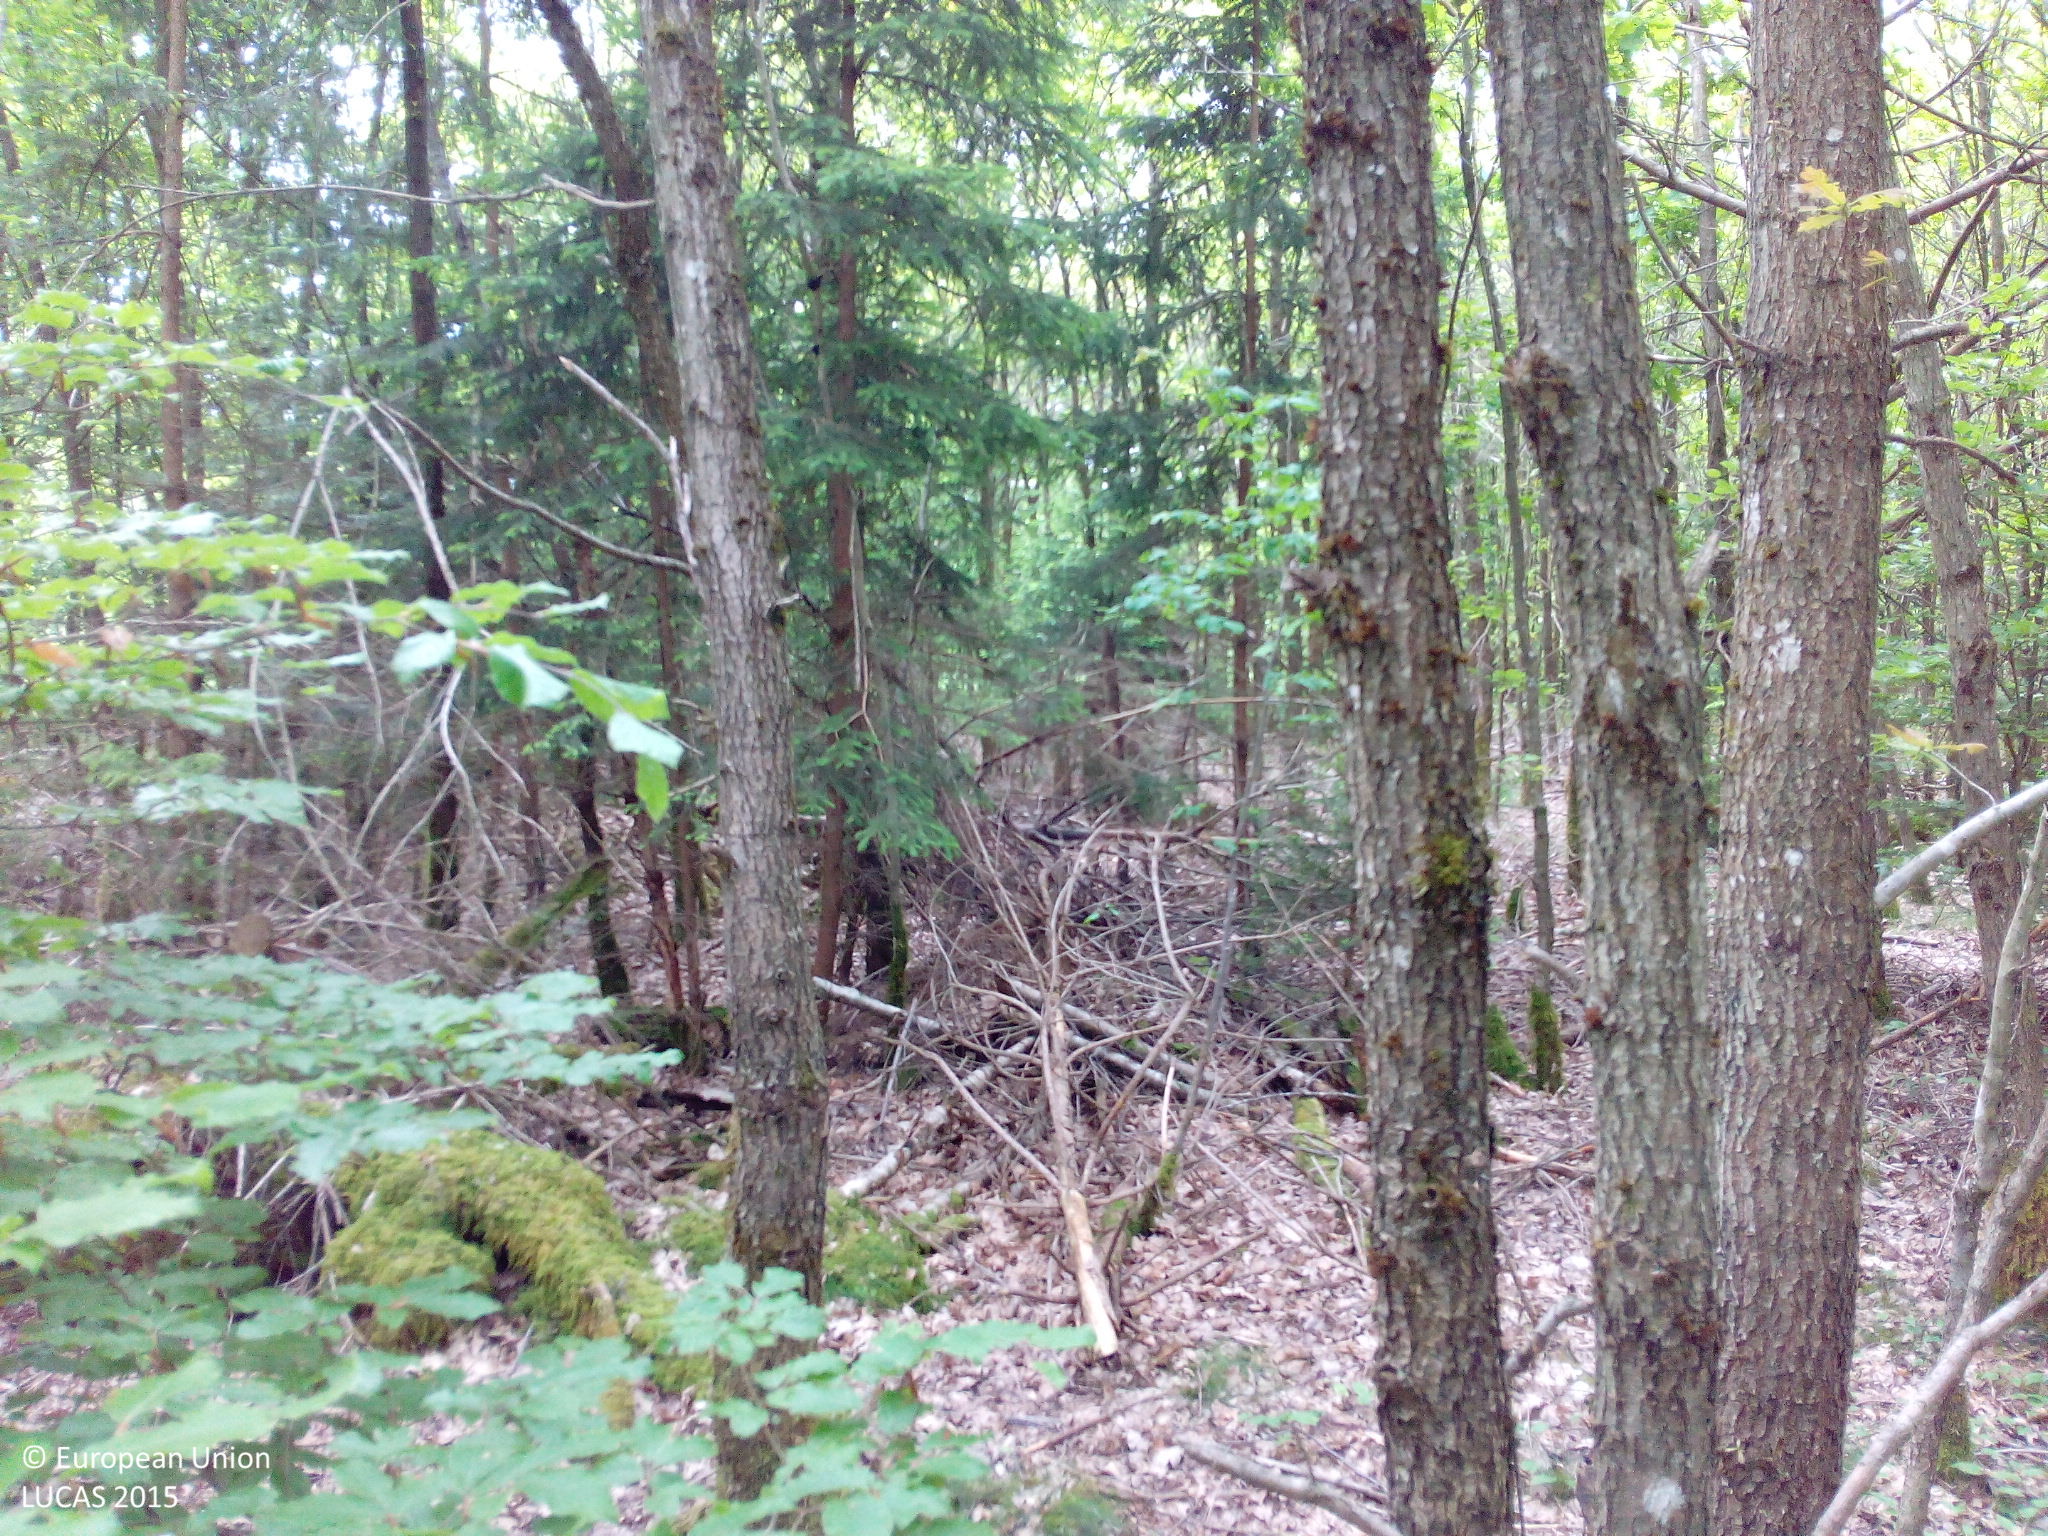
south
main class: Woodland
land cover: Spruce dominated mixed woodland
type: hemiboreal forest and nemoral coniferous forest and mixed broadleaved-coniferous forest
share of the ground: > 75 %
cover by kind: coniferous forest trees 75 %, broadleaved forest trees 25 %
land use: Forestry
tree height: > 5 m
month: May
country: DE
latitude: 48.0684
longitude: 11.5692
